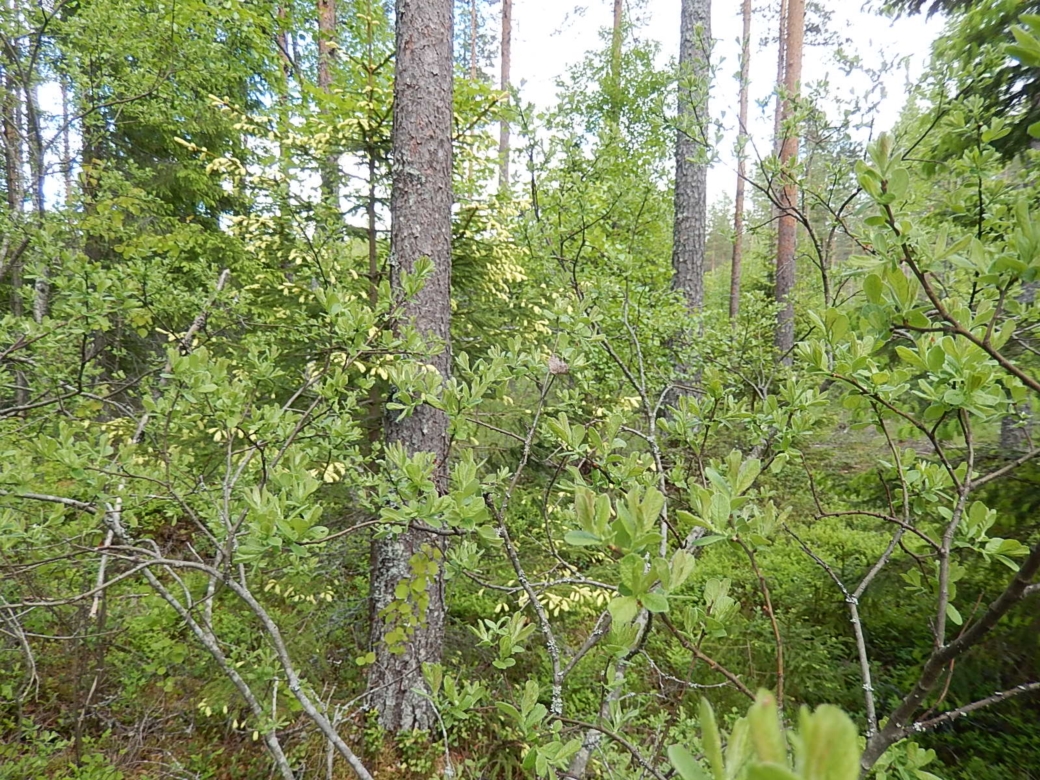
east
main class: Woodland
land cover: Pine dominated coniferous woodland
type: boreal forest
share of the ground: > 75 %
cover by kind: coniferous forest trees 70 %, broadleaved forest trees 15 %, shrubs 10 %, lichens and mosses 5 %
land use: Forestry
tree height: > 5 m
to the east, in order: Pine dominated coniferous woodland; Ditches and canals; Broadleaved woodland; Pine dominated coniferous woodland; Ditches and canals; Pine dominated coniferous woodland; Ditches and canals; Pine dominated coniferous woodland
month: June
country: FI
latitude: 62.1219
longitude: 22.9673
